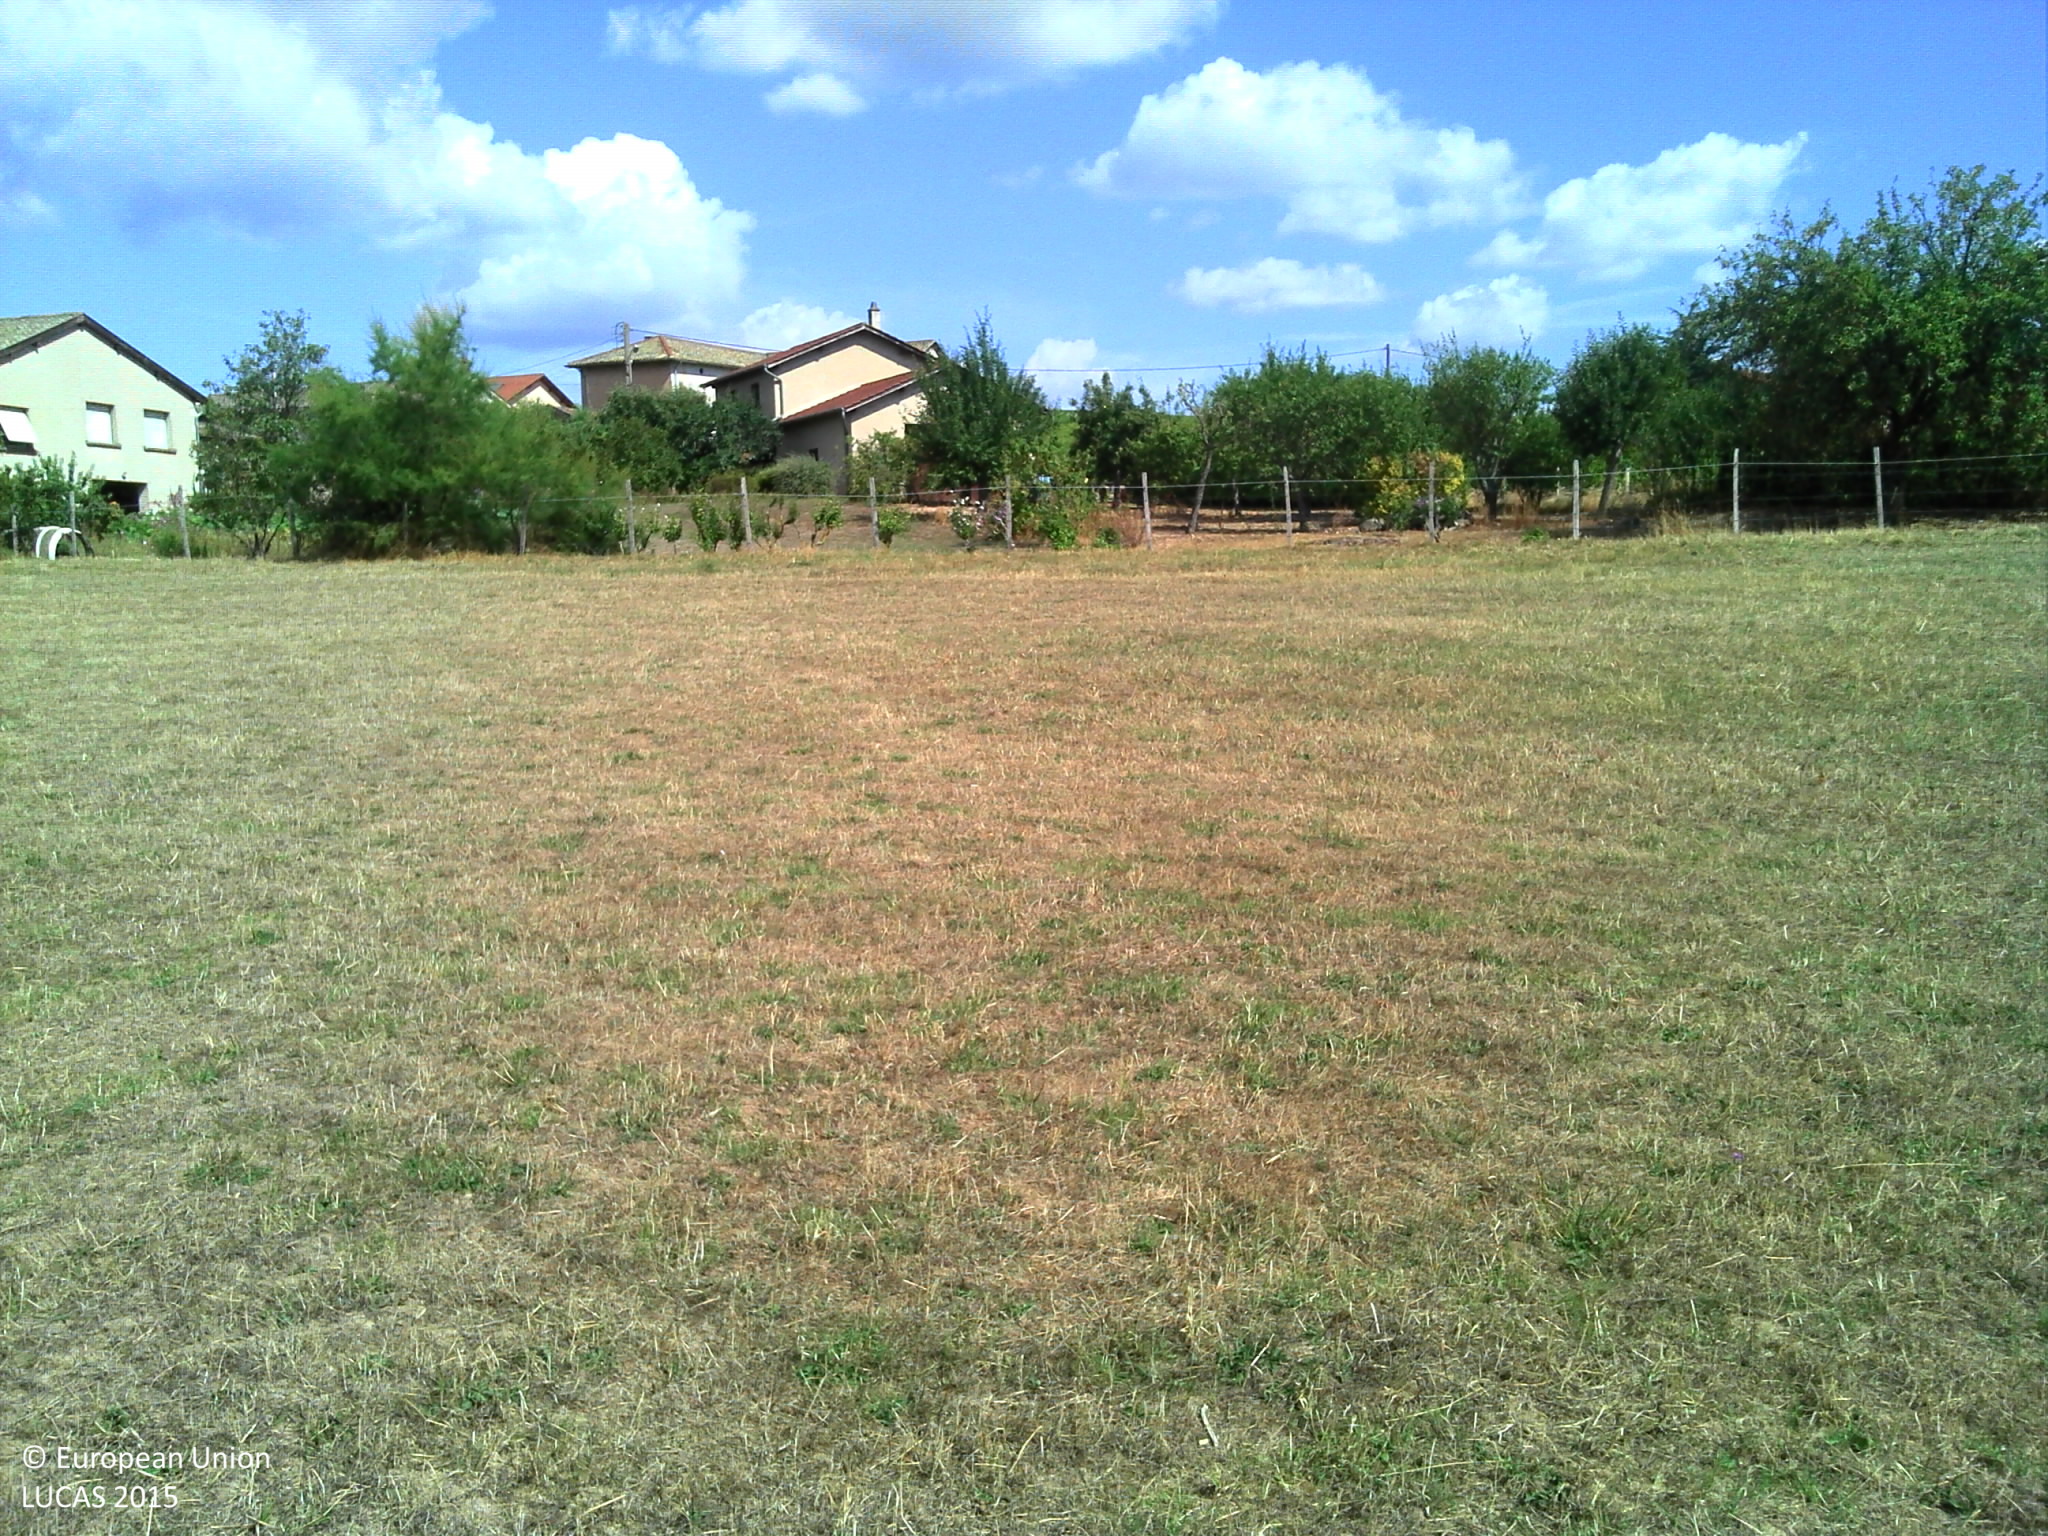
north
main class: Grassland
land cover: Grassland without tree/shrub cover
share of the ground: > 75 %
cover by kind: herbaceous plants 100 %
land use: Agriculture (excluding fallow land and kitchen gardens)
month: August
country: FR
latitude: 46.1454
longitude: 4.6555
